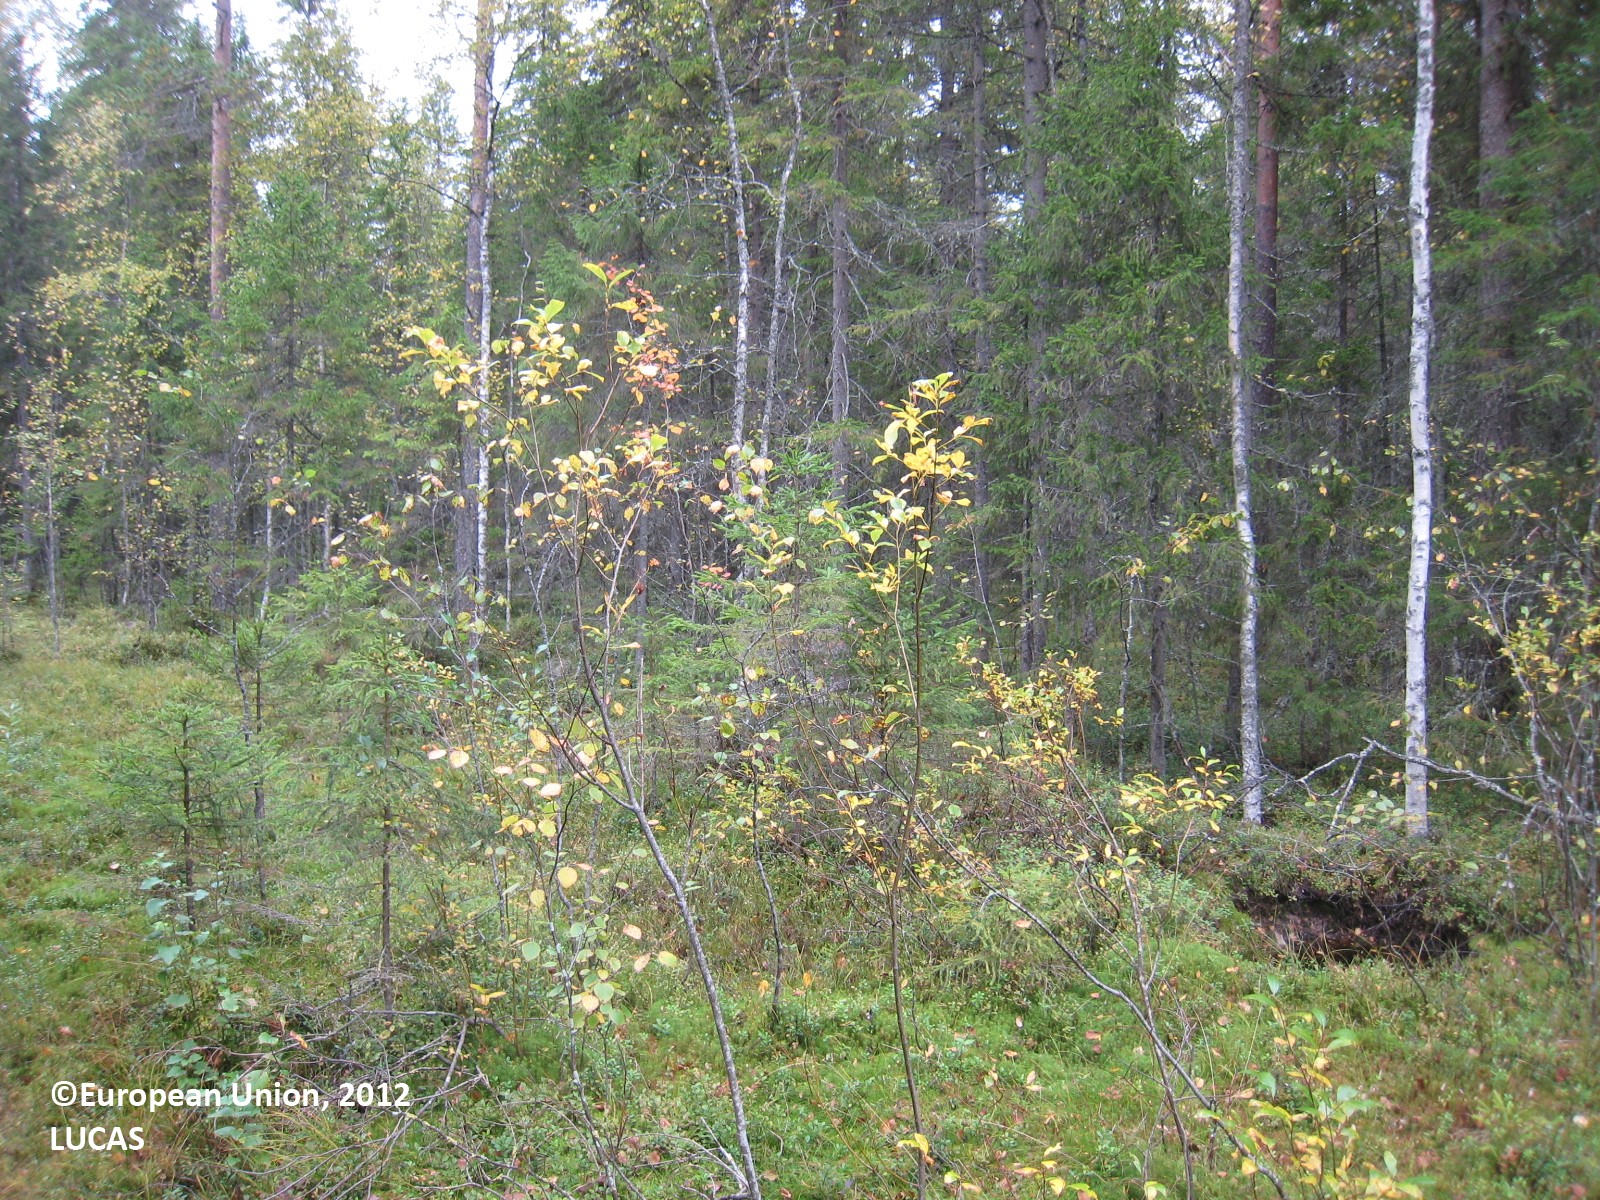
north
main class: Woodland
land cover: Spruce dominated mixed woodland
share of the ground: 25 - 50 %
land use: Forestry
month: September
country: FI
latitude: 63.2404
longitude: 26.3910
